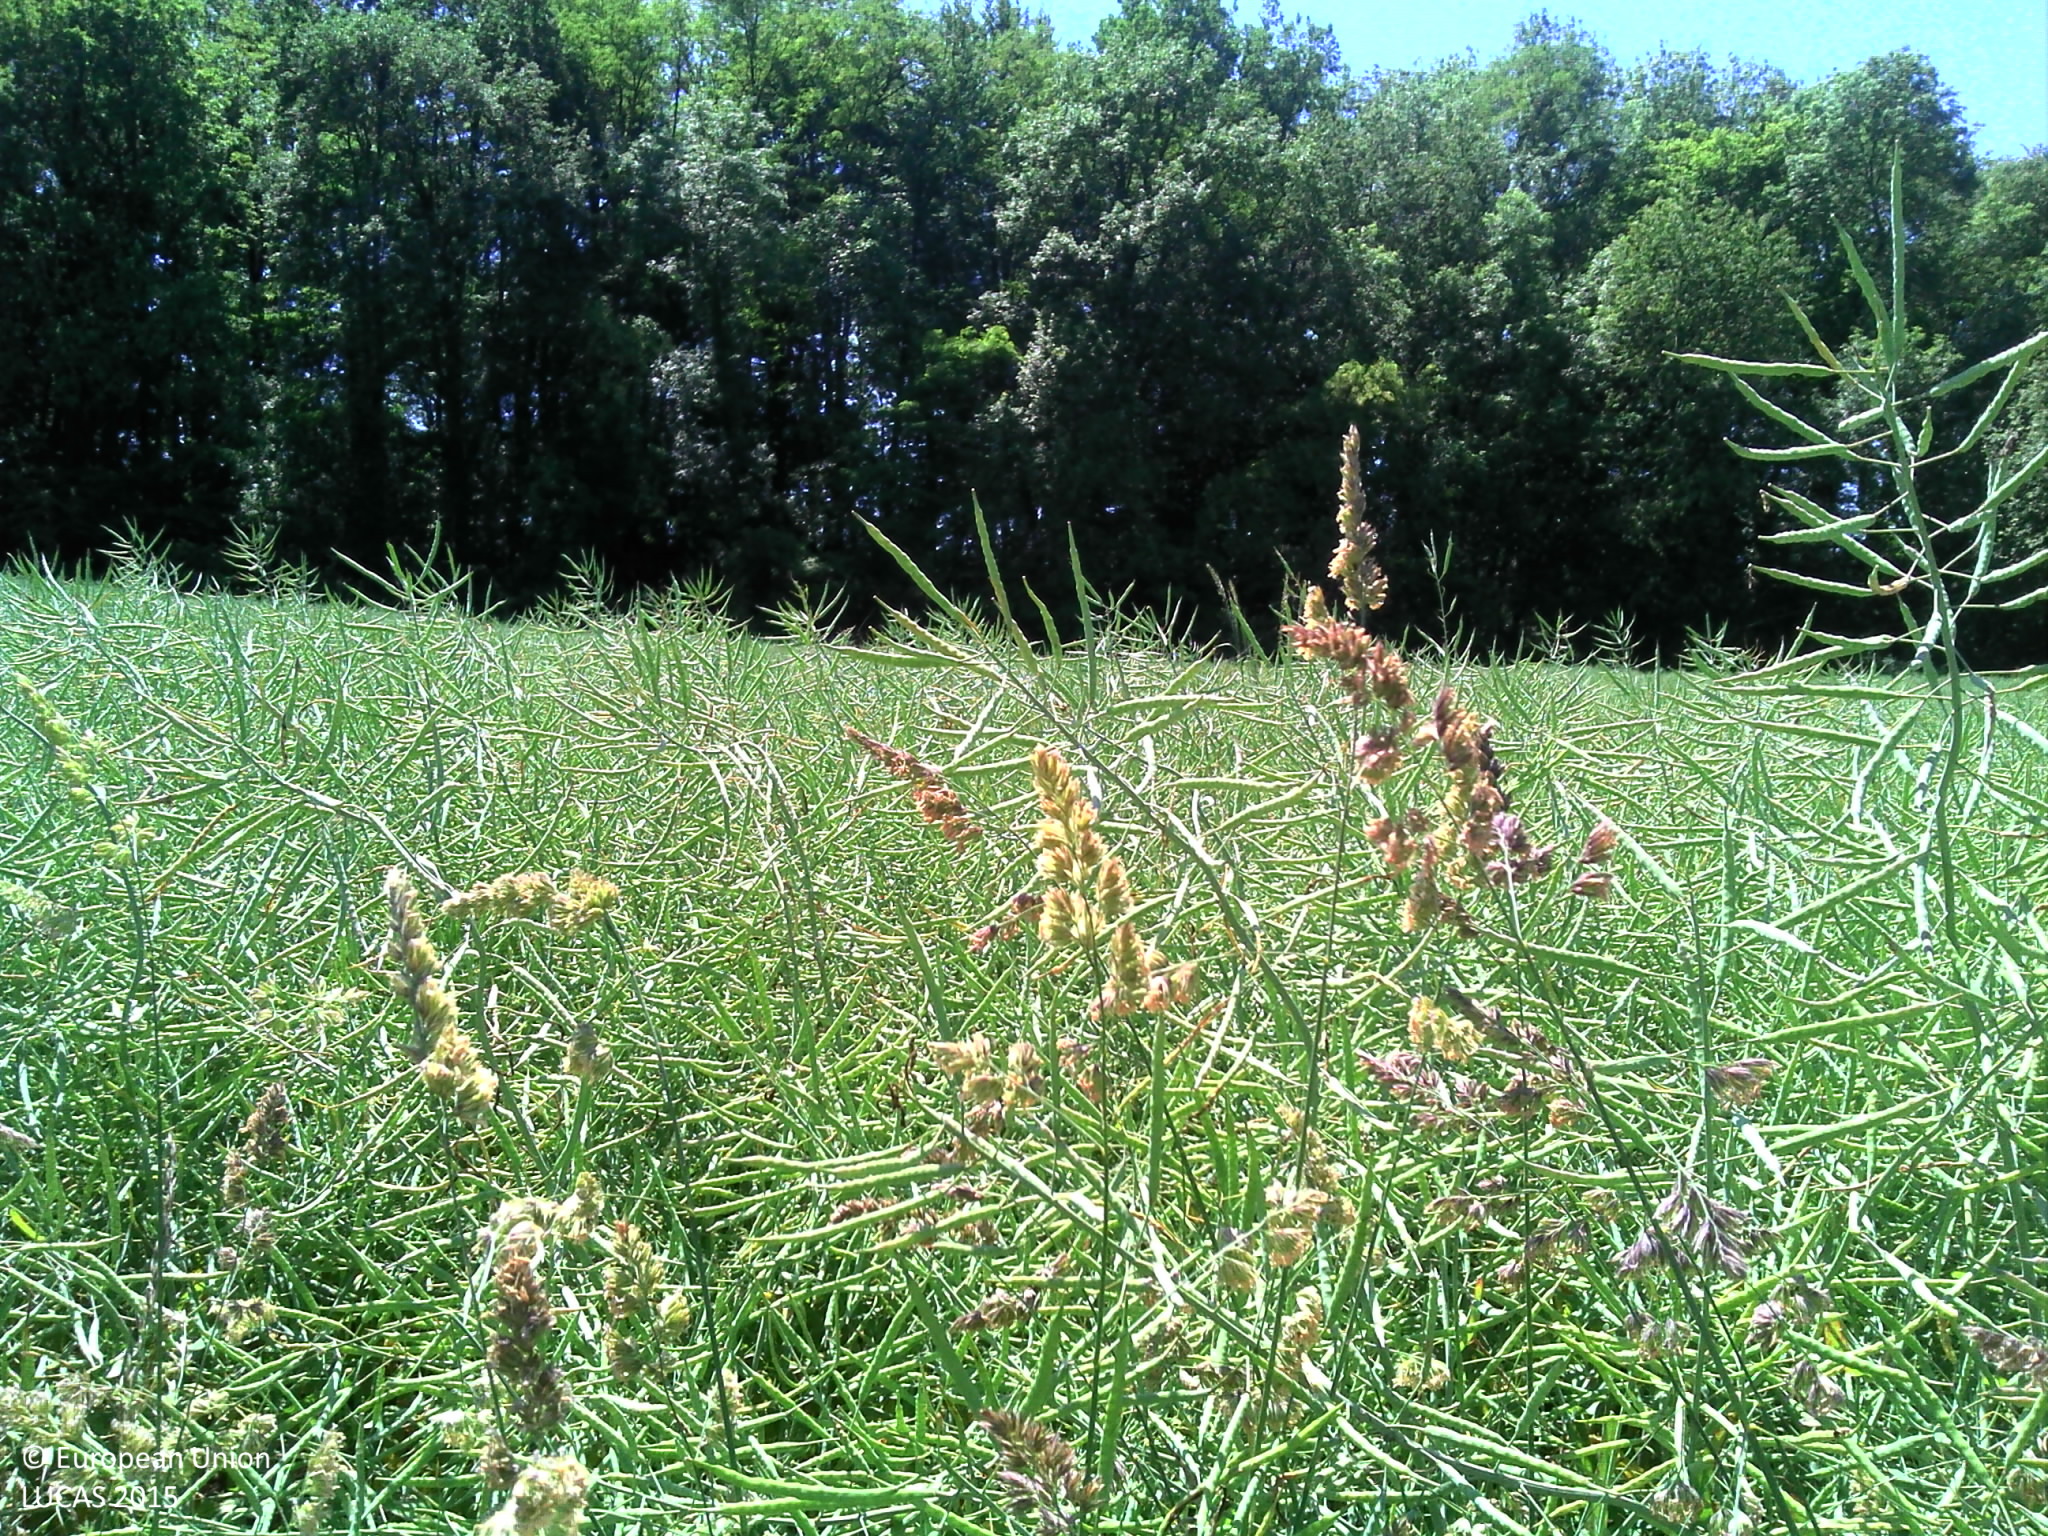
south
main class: Cropland
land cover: Rape and turnip rape
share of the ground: > 75 %
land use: Agriculture (excluding fallow land and kitchen gardens)
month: June
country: FR
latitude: 47.5394
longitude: 6.0290
